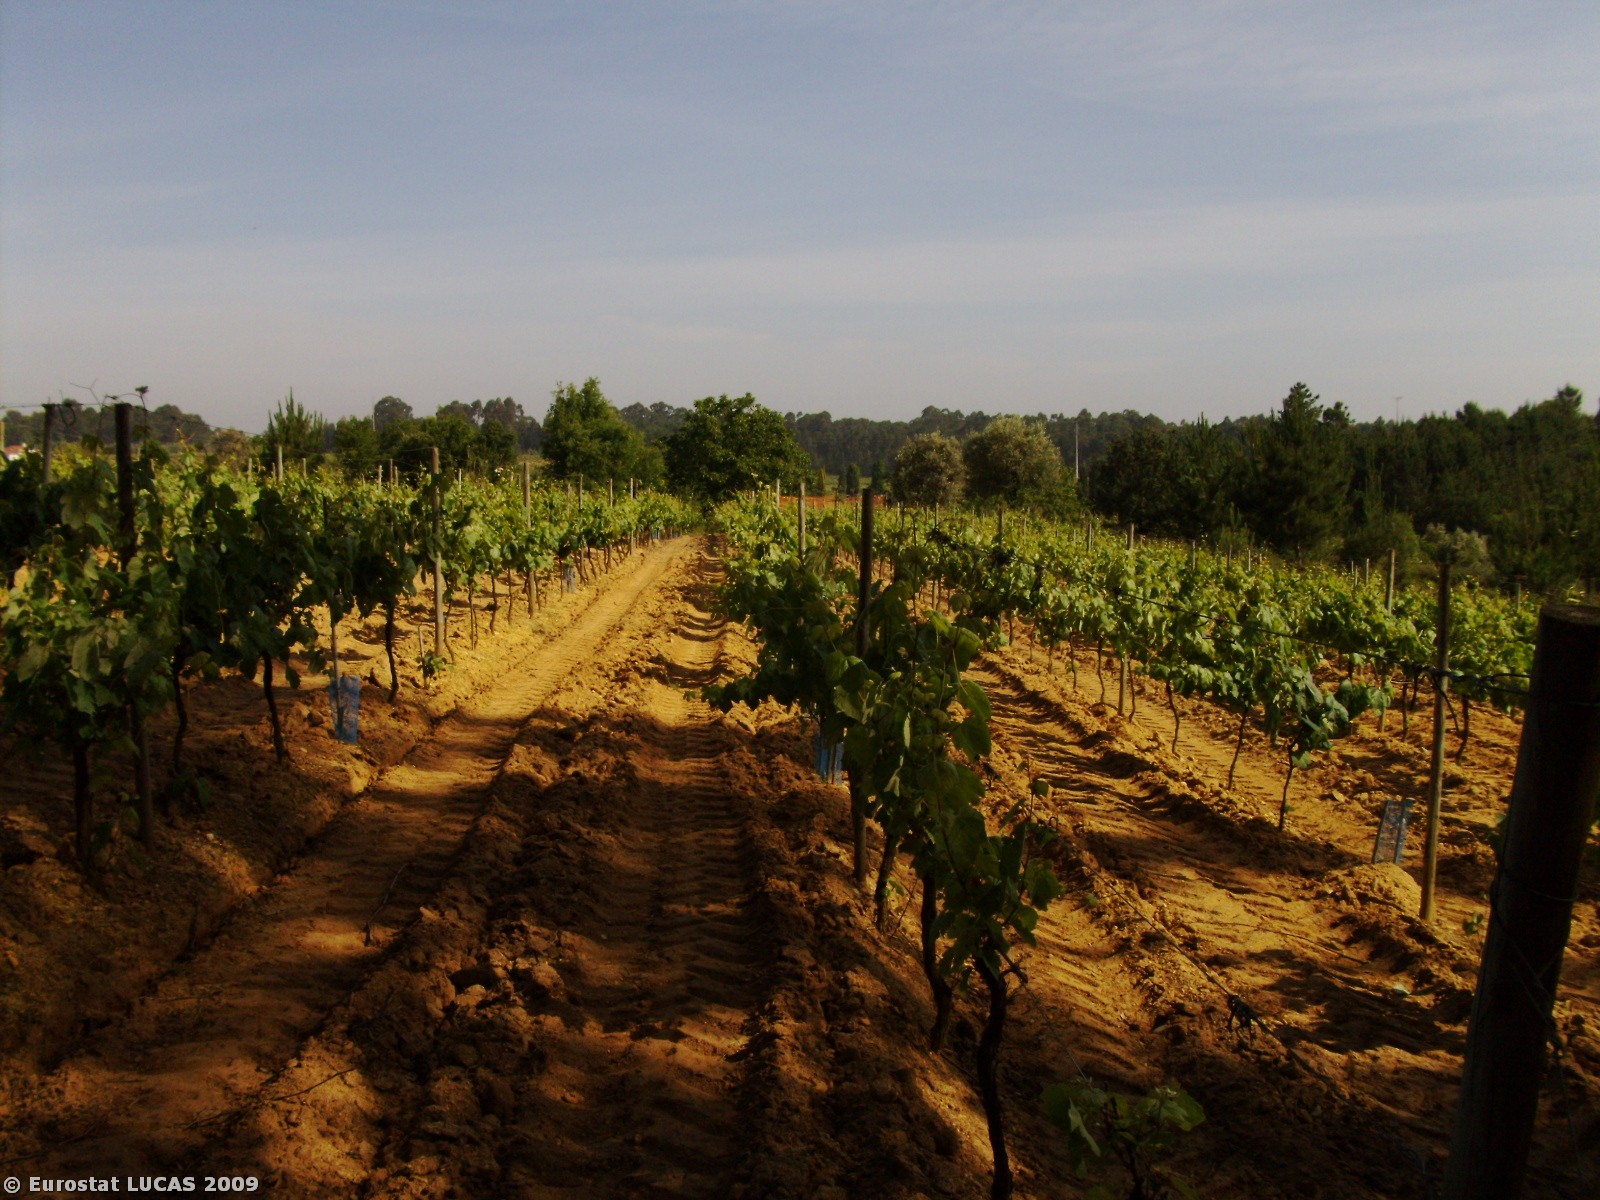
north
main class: Cropland
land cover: Vineyards
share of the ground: 25 - 50 %
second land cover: Bare land
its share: 25 - 50 %
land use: Agriculture (excluding fallow land and kitchen gardens)
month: May
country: PT
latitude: 40.4172
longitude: -8.4857
